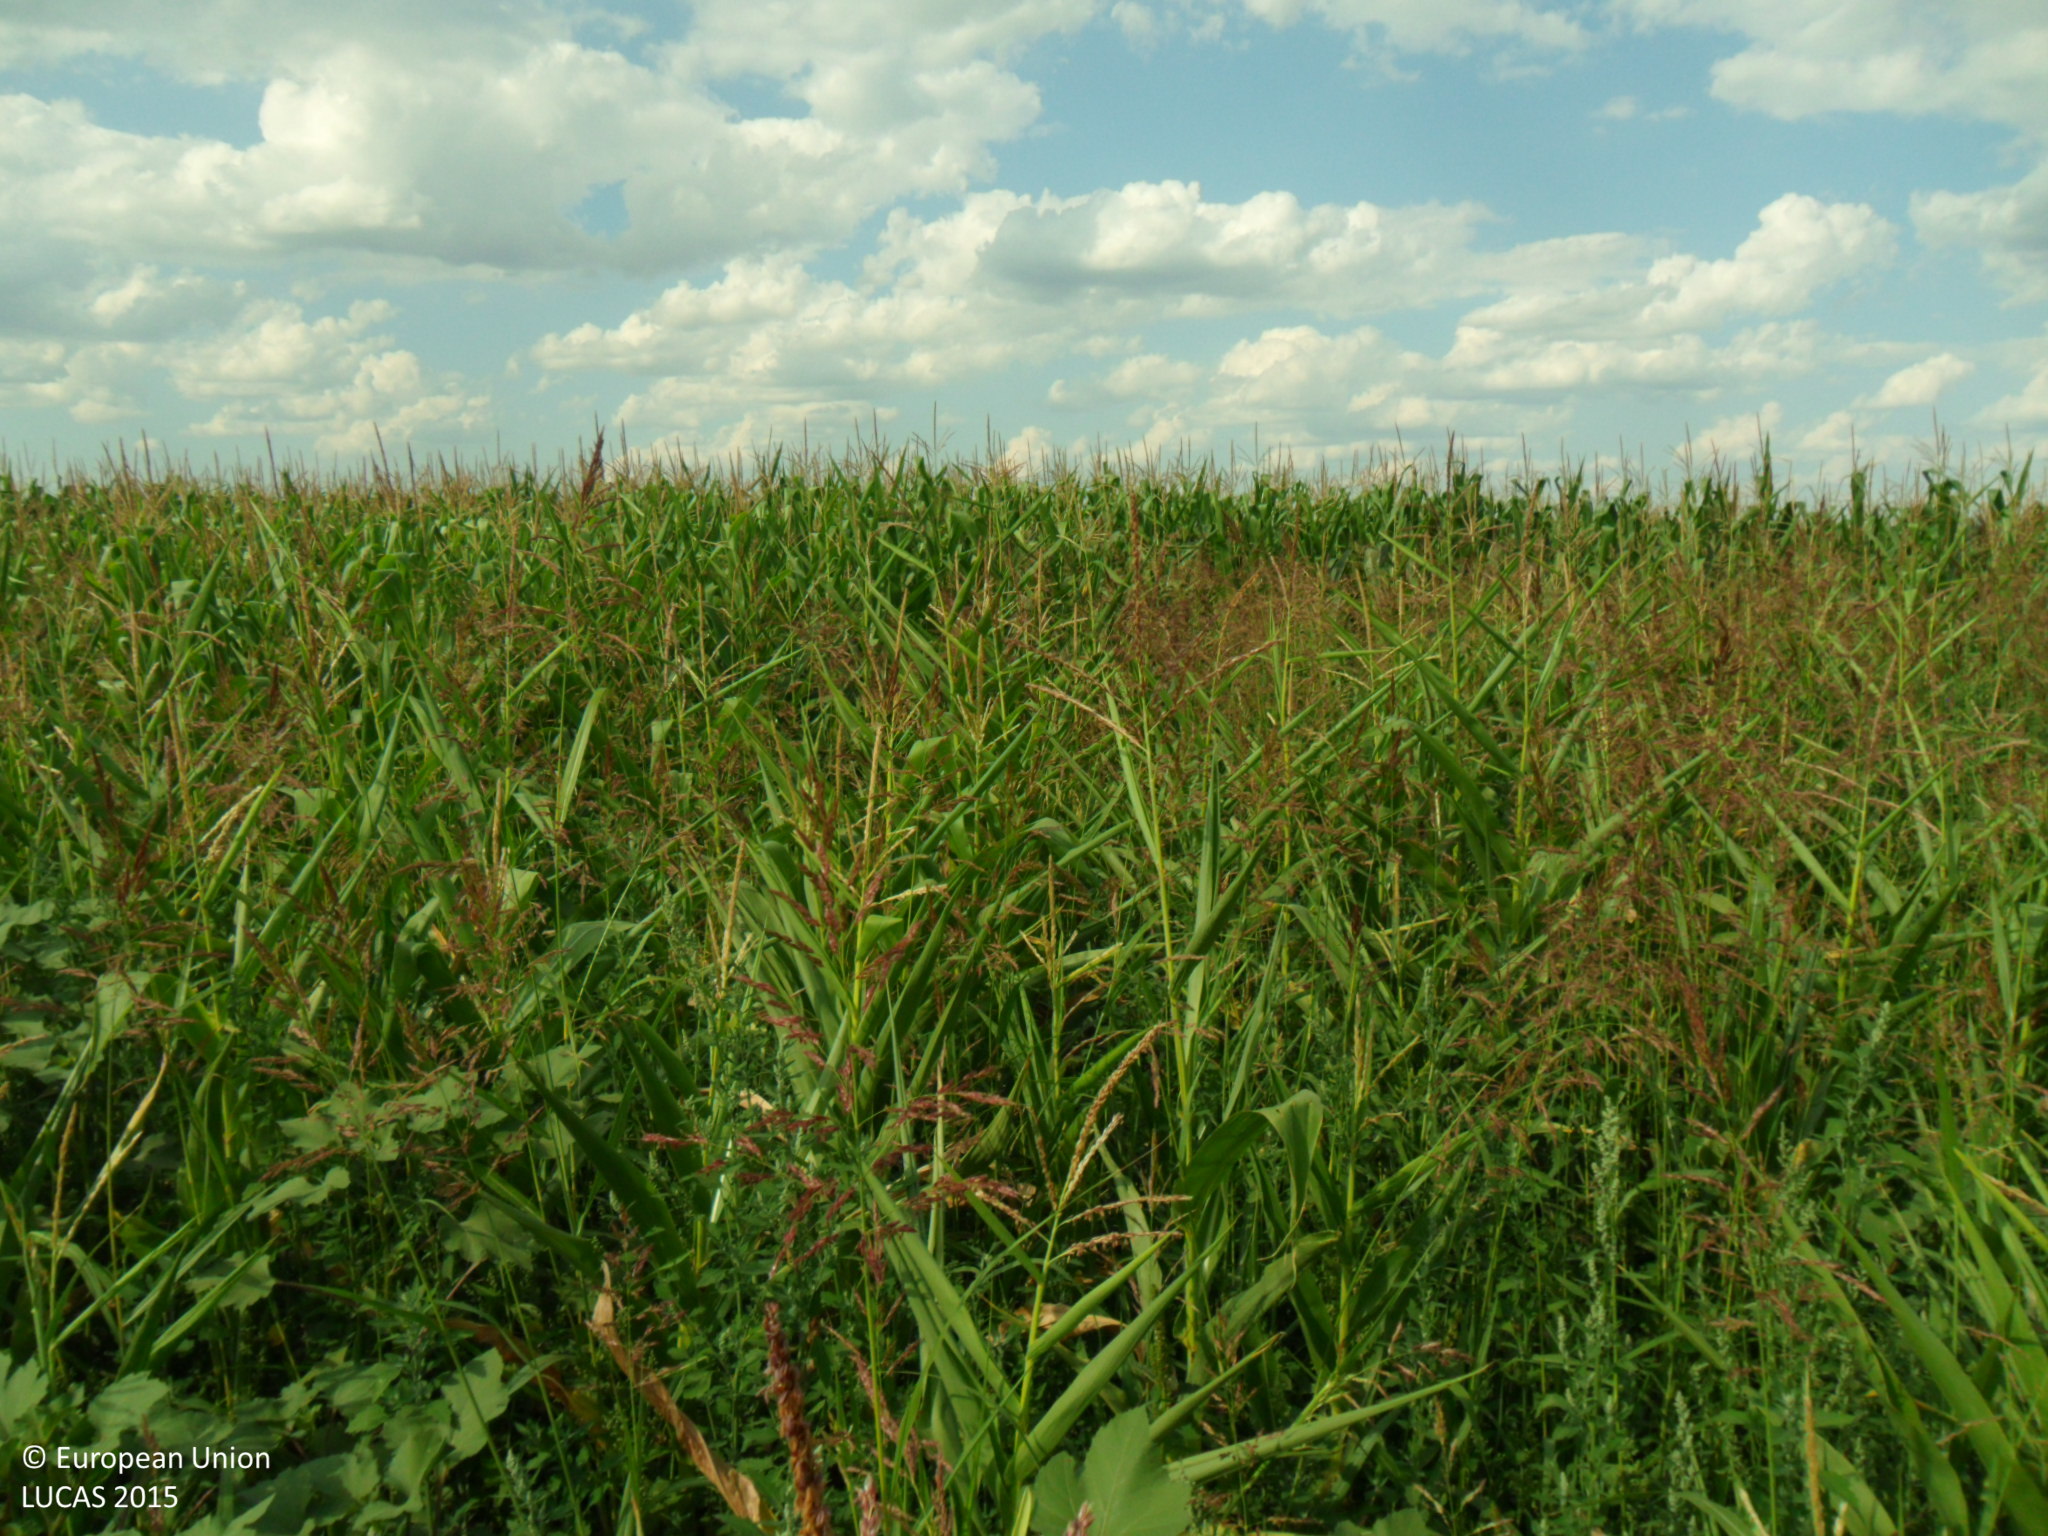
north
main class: Cropland
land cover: Maize
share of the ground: > 75 %
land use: Agriculture (excluding fallow land and kitchen gardens)
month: July
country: BG
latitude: 43.1995
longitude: 26.9604
